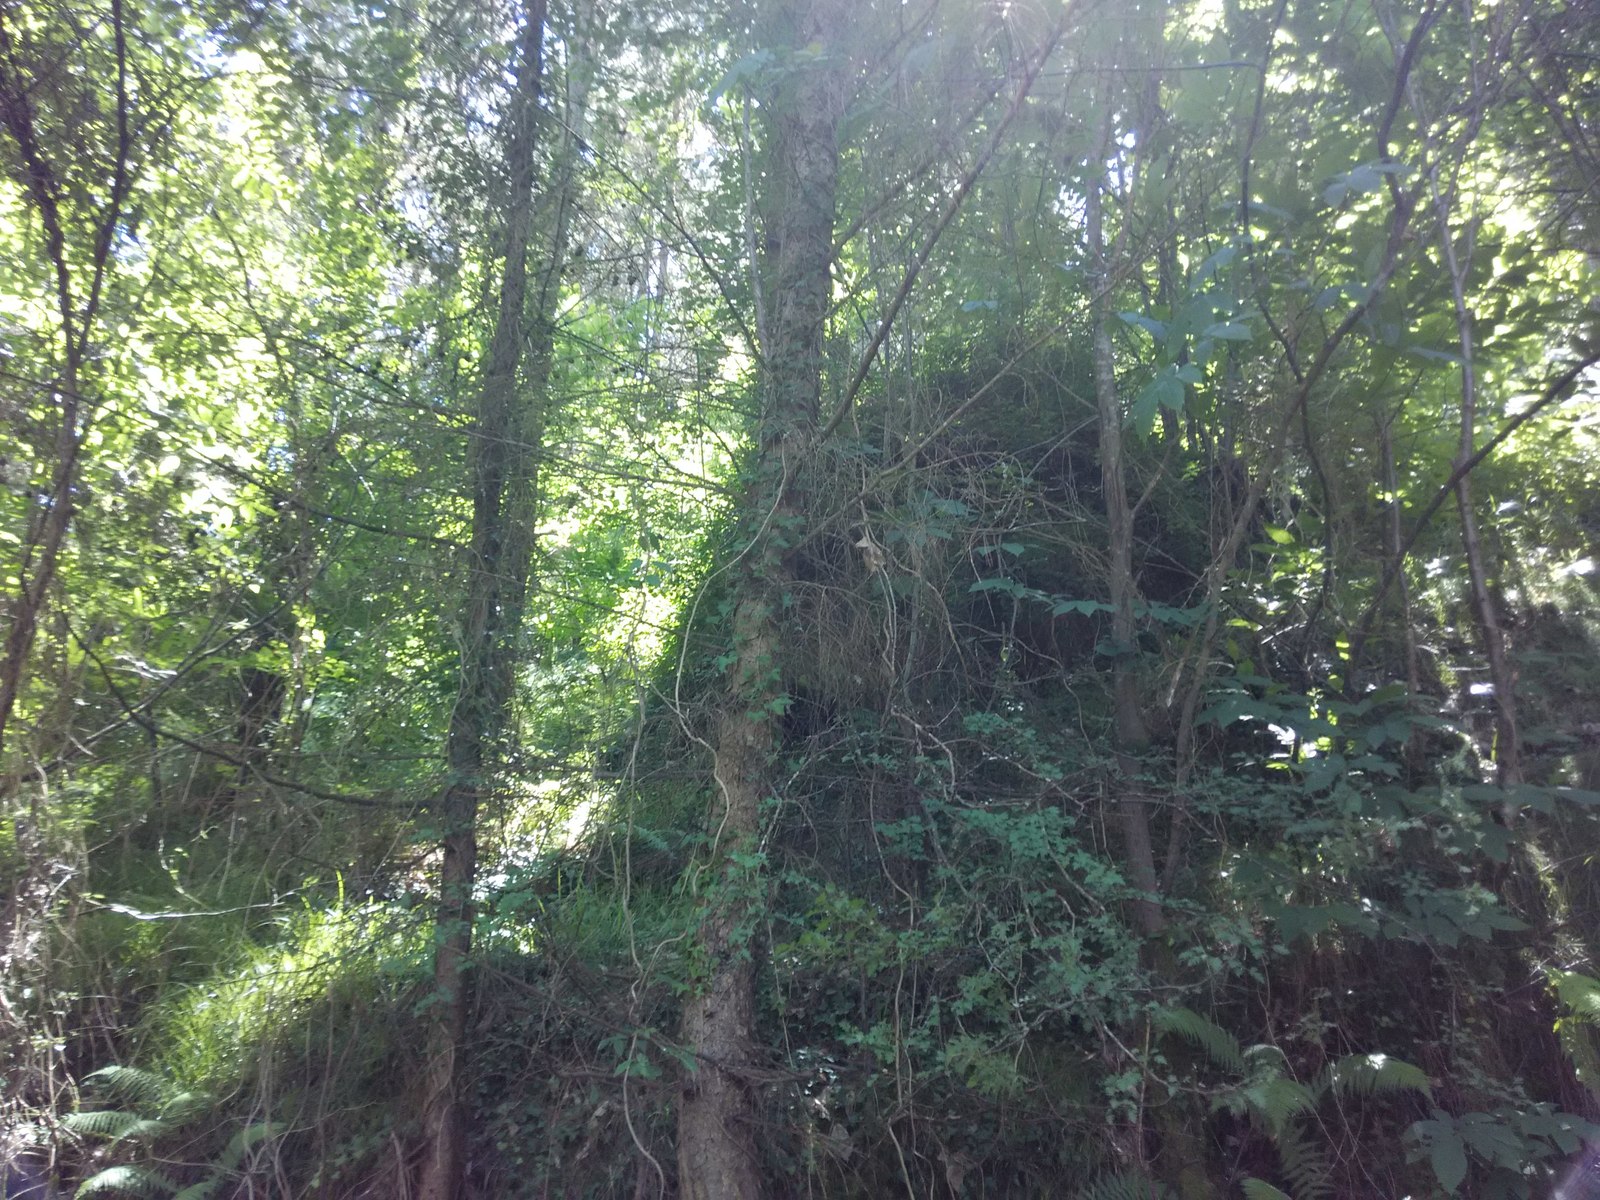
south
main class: Woodland
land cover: Pine dominated coniferous woodland
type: exotic forest
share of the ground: > 75 %
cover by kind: coniferous forest trees 95 %, shrubs 5 %
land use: Forestry
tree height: > 5 m
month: June
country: ES
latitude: 43.2001
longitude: -2.4197
